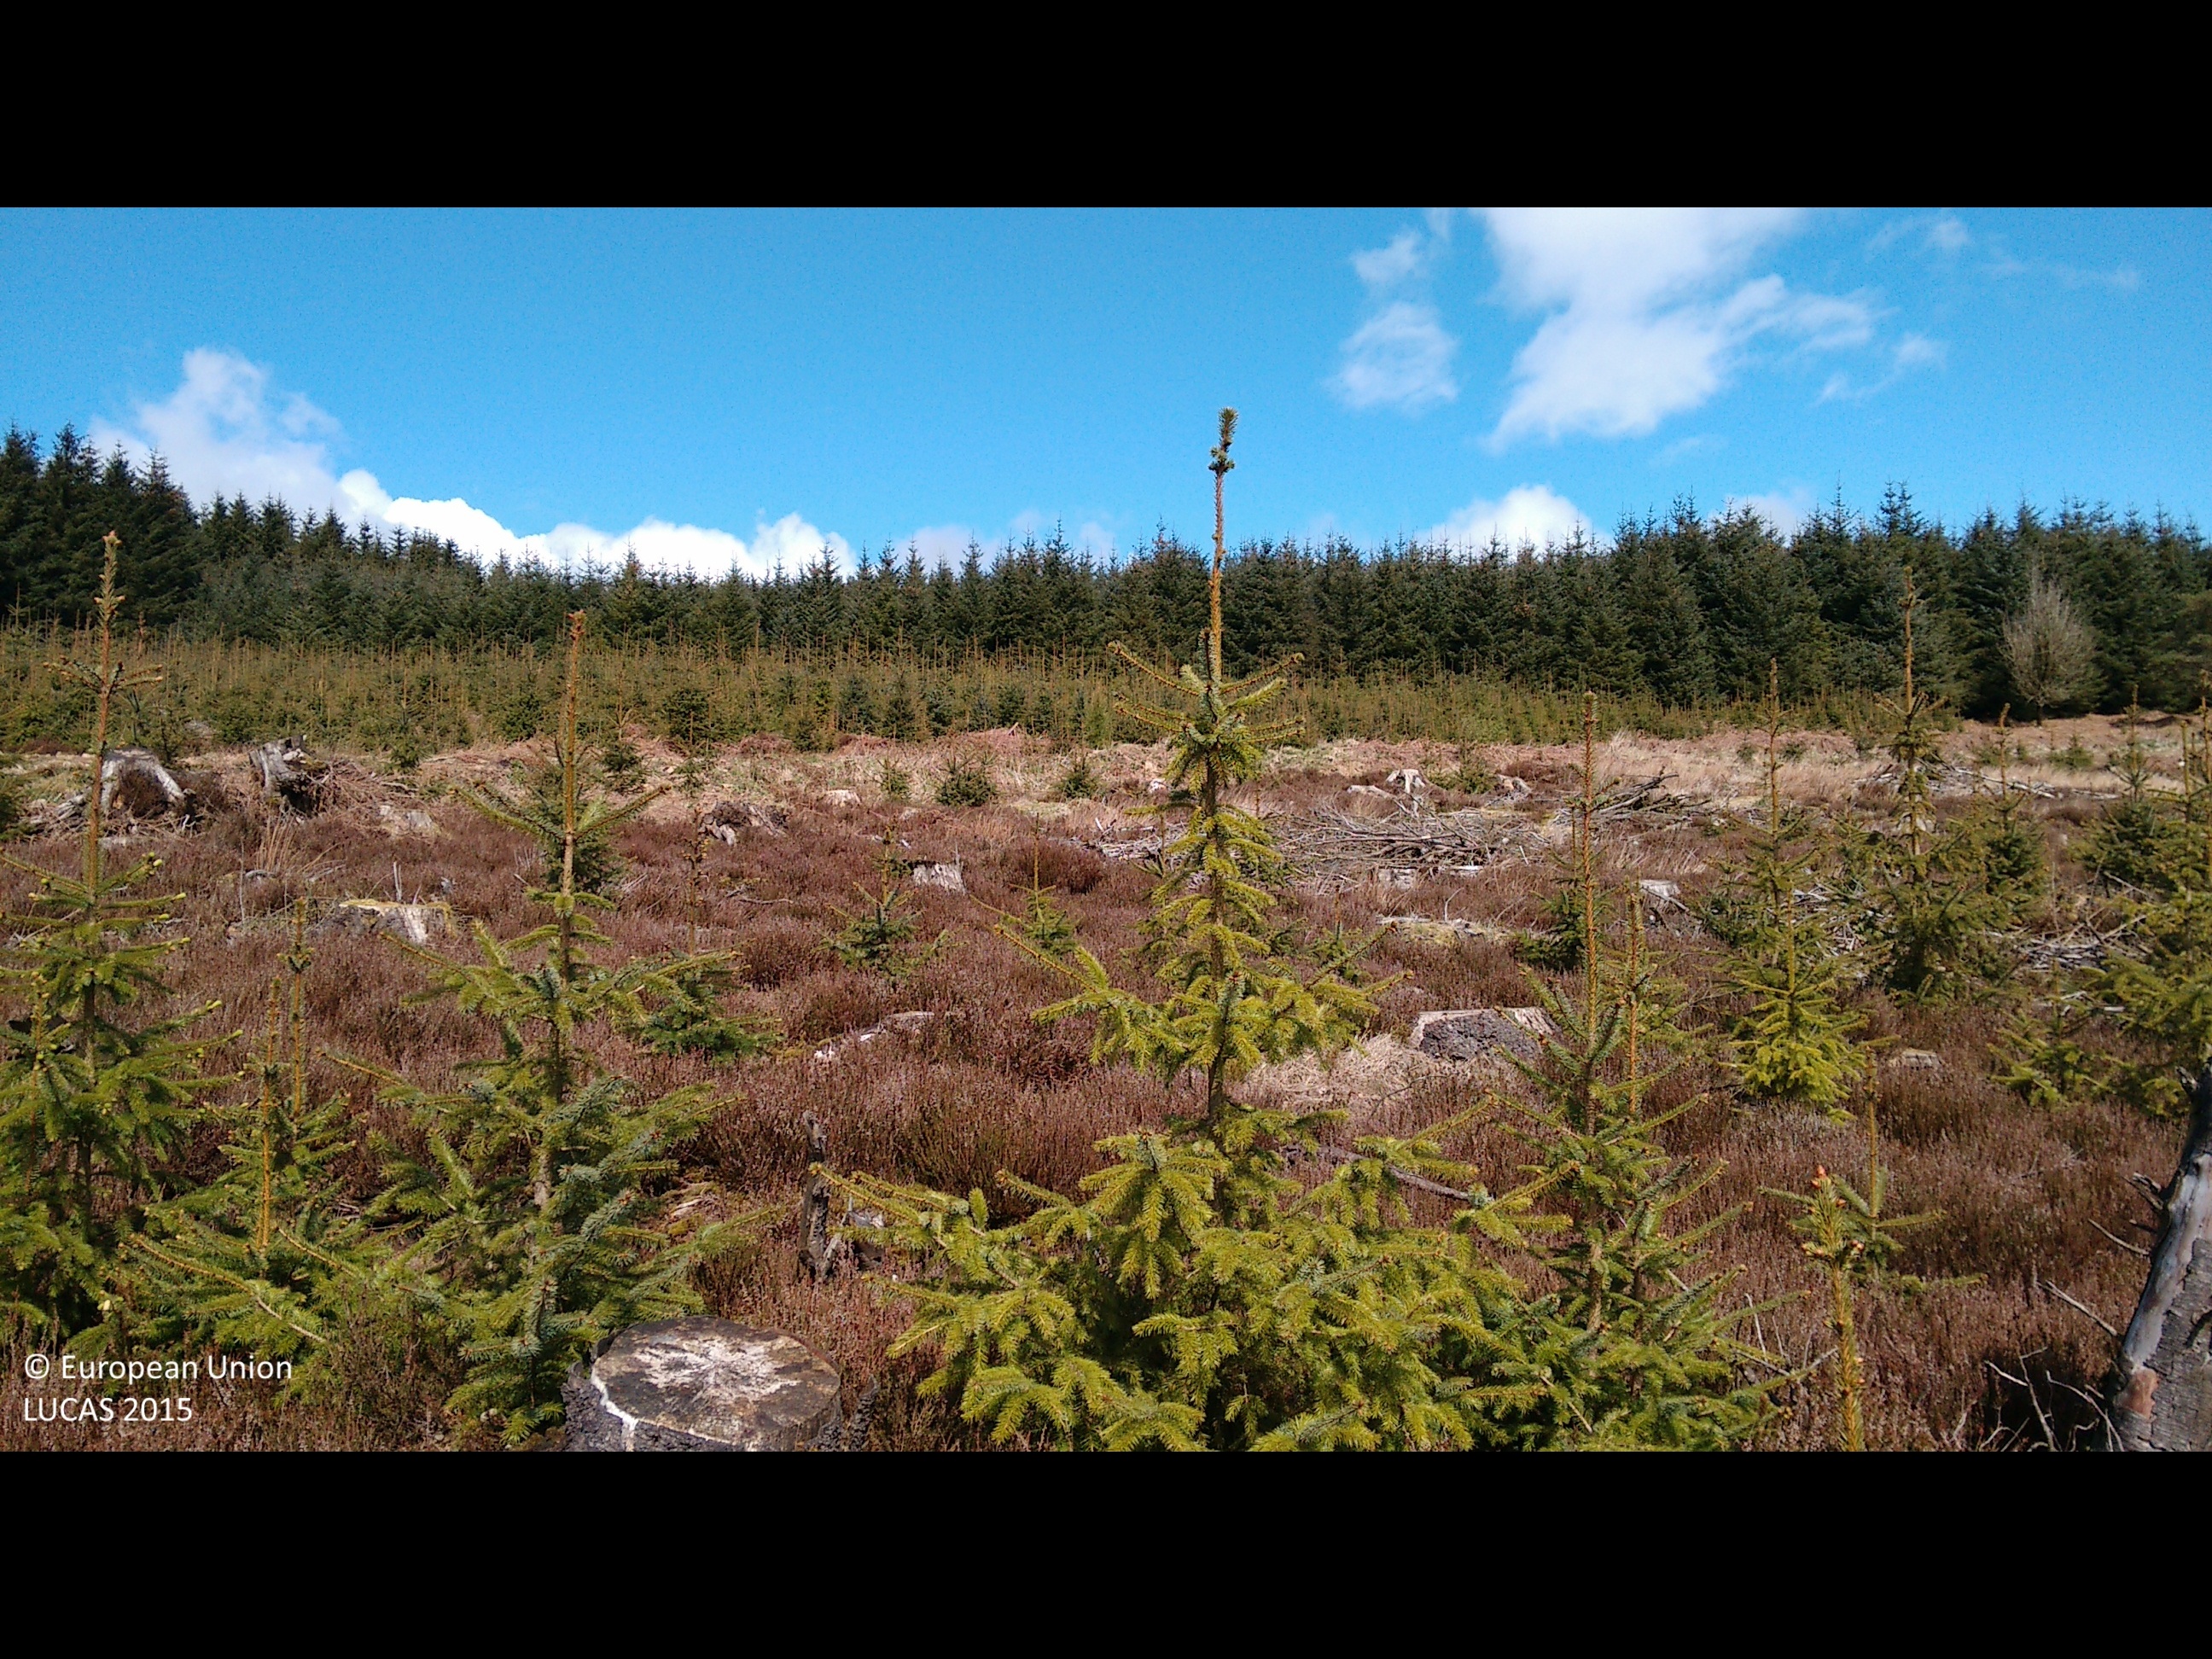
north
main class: Woodland
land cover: Spruce dominated coniferous woodland
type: exotic forest
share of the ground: 25 - 50 %
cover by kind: coniferous forest trees 50 %, herbaceous plants 35 %, shrubs 15 %
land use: Forestry
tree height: < 5 m
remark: Clear cut
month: April
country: GB
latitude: 53.8597
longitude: -2.5178
